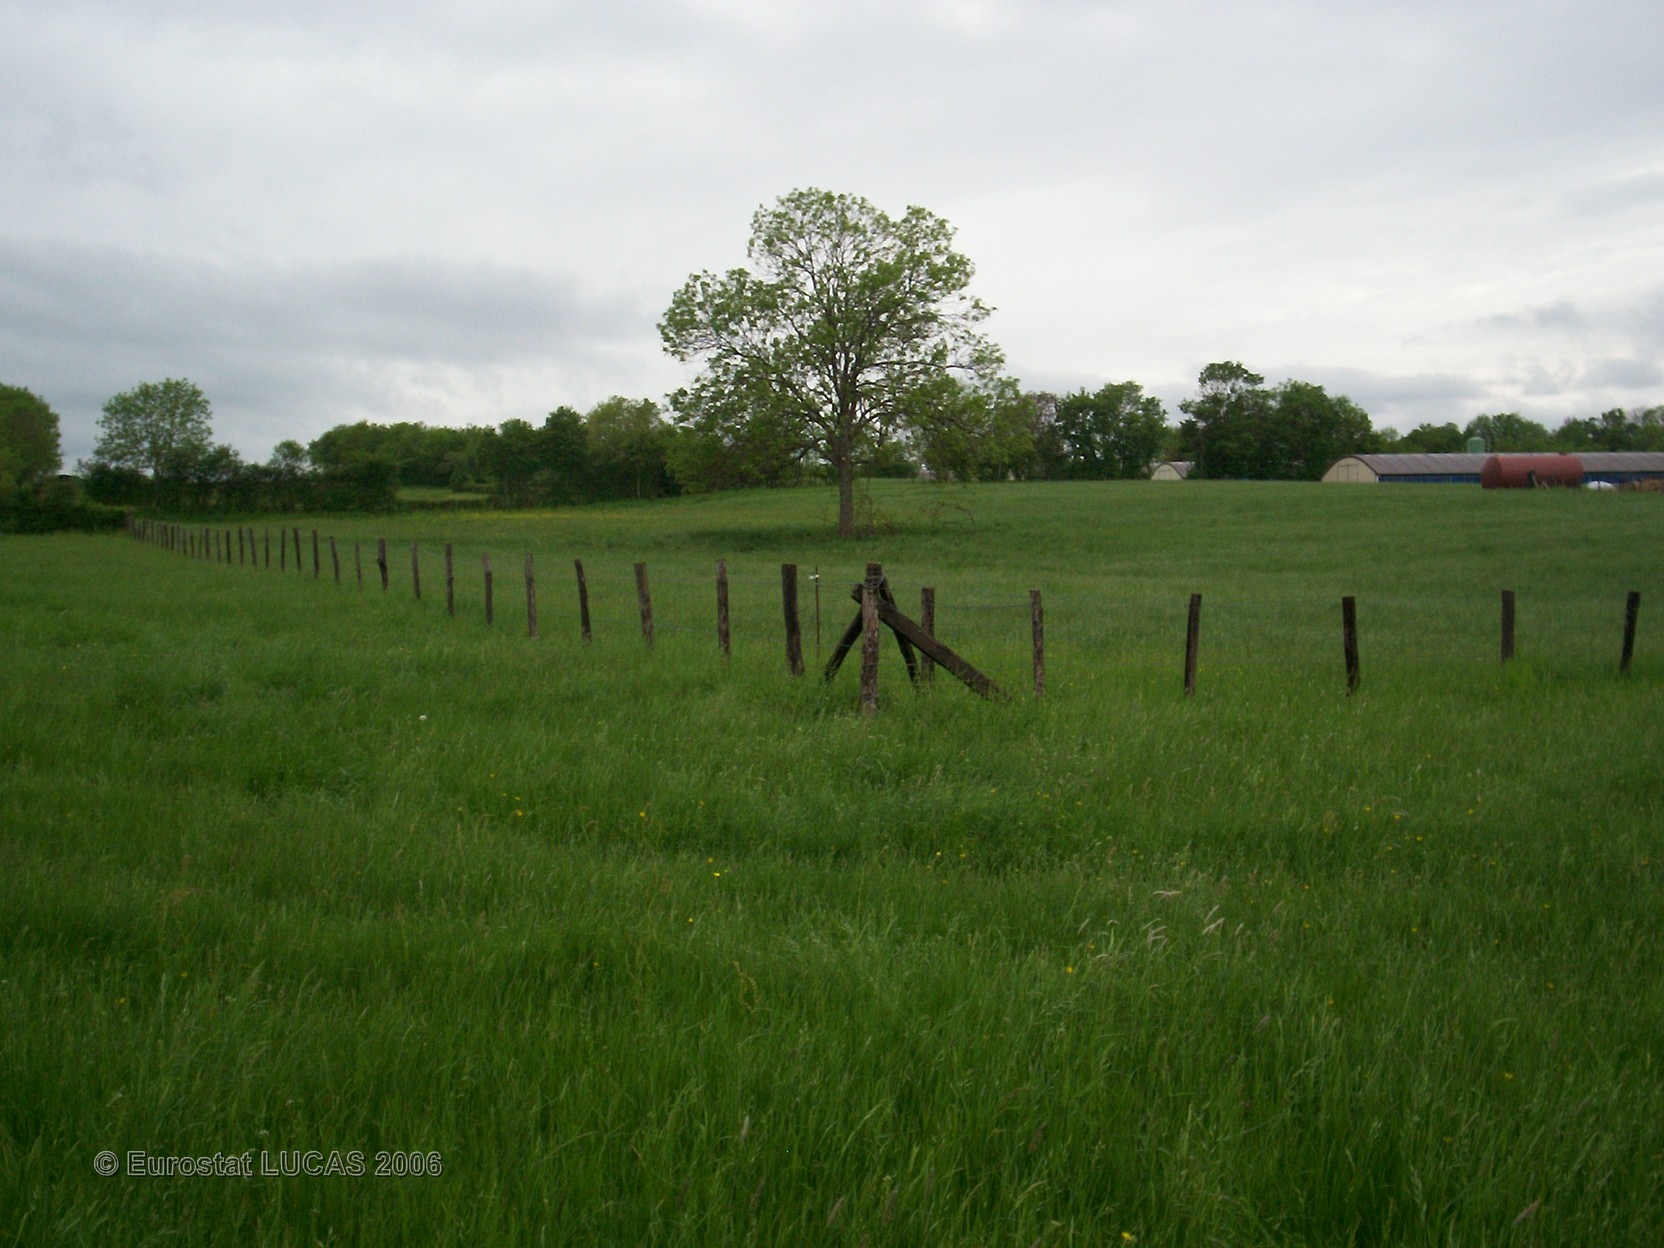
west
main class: Grassland
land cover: Grassland without tree/shrub cover
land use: Agriculture (excluding fallow land and kitchen gardens)
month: May
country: FR
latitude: 47.2061
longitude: 4.5739
